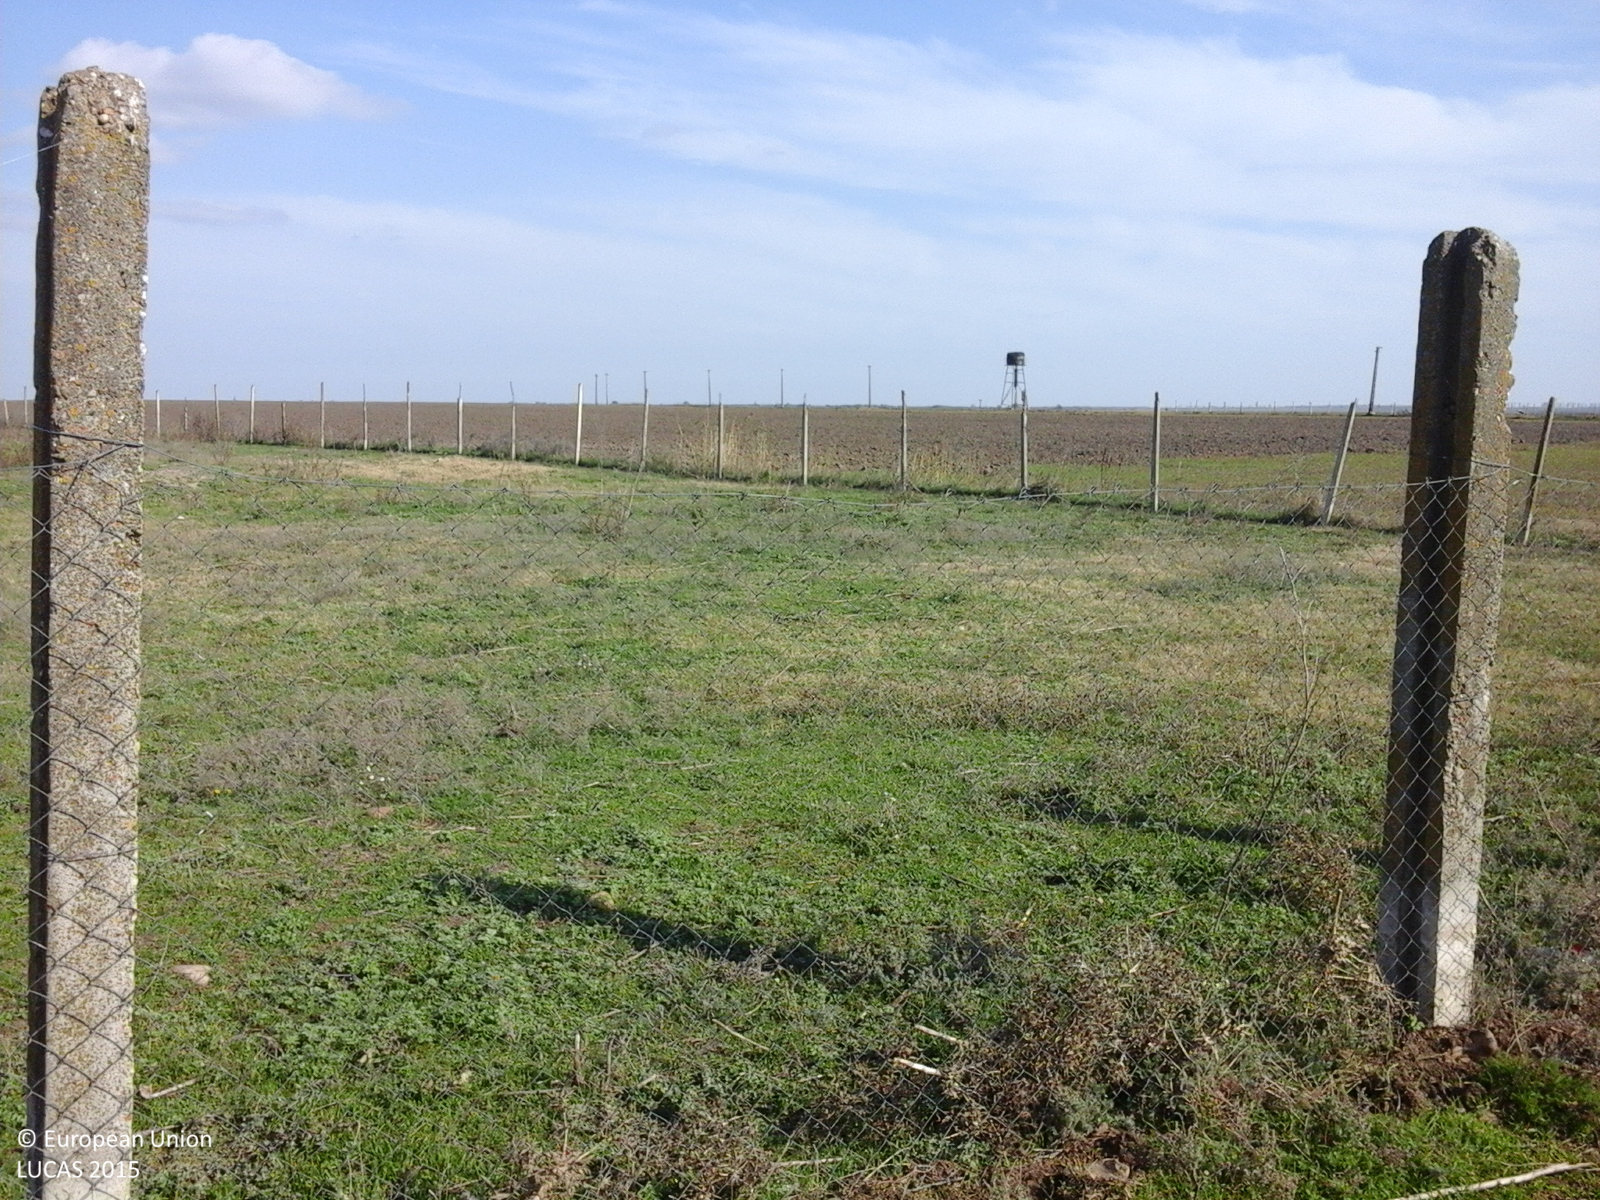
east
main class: Grassland
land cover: Spontaneously vegetated surfaces
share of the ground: > 75 %
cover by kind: herbaceous plants 100 %
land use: Fallow land
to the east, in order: Spontaneously vegetated surfaces; Fences; Other bare soil; Common wheat; Fences; Spontaneously vegetated surfaces; Tracks; Spontaneously vegetated surfaces
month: October
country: RO
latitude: 45.2306
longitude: 27.2494
